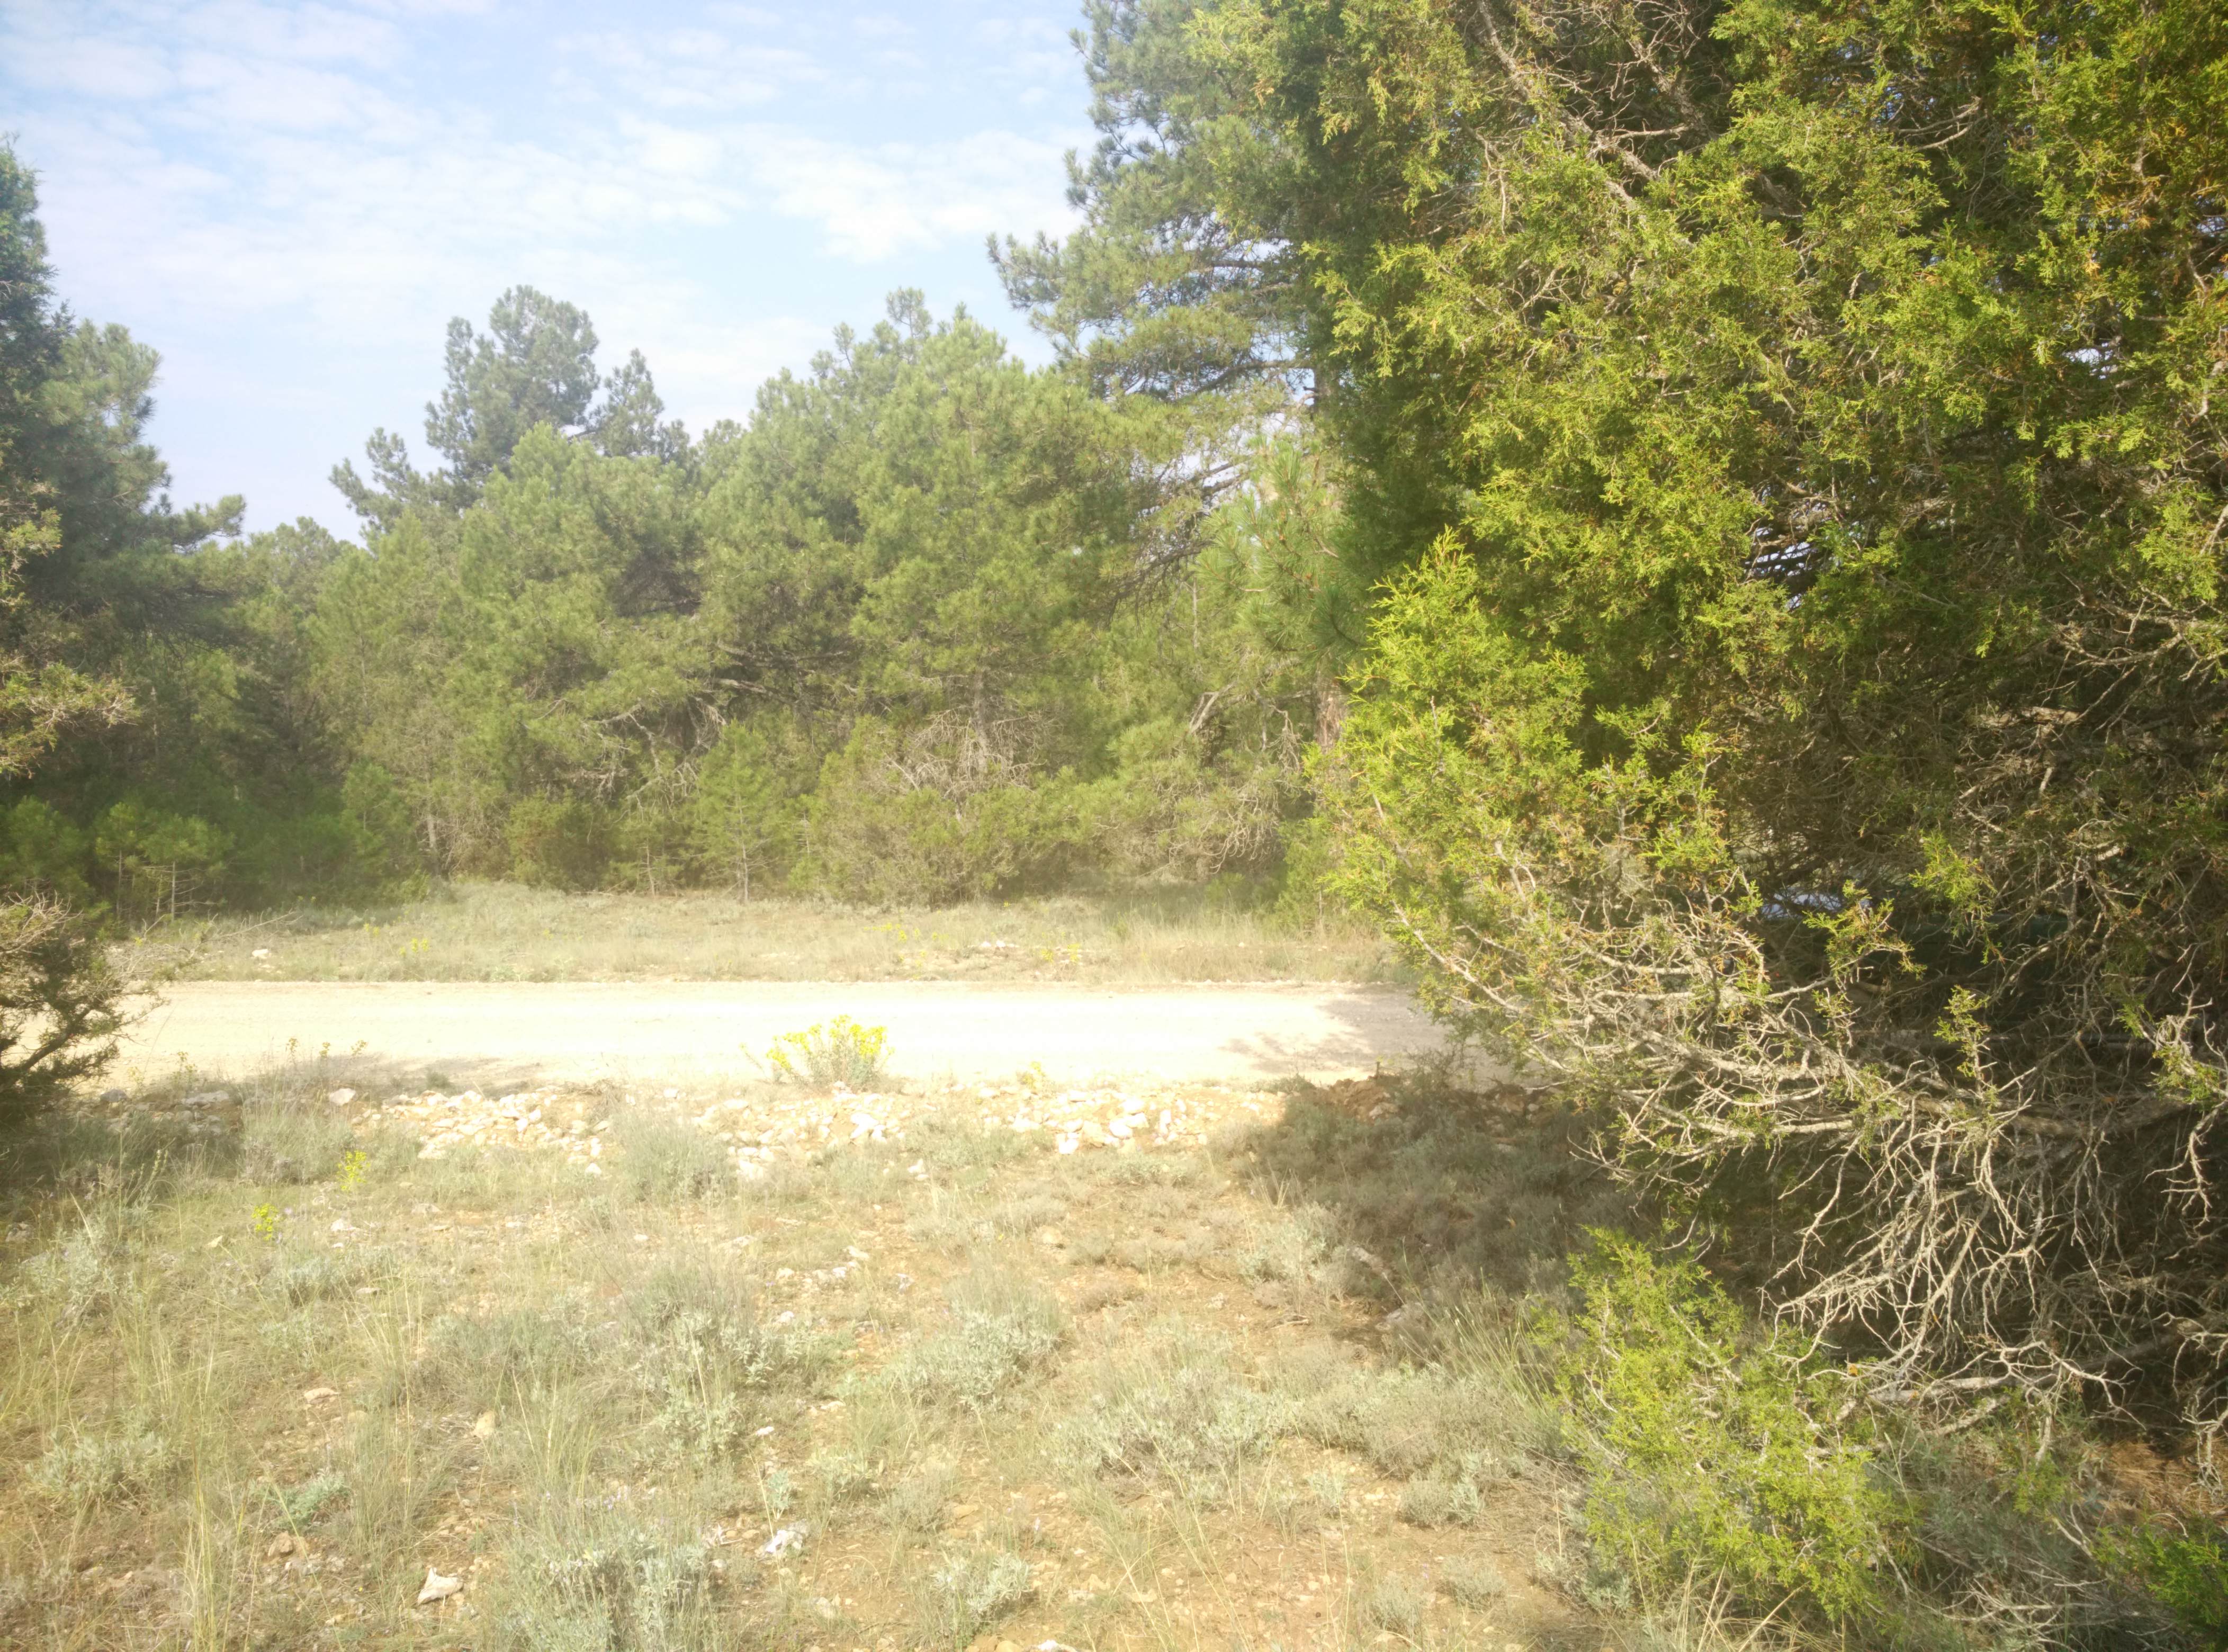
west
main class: Woodland
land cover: Pine dominated coniferous woodland
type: coniferous forest of the mediterranean region
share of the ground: 25 - 50 %
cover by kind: unconsolidated bare surface 40 %, coniferous forest trees 35 %, shrubs 20 %, herbaceous plants 5 %
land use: Semi-natural and natural areas not in use
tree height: > 5 m
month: June
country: ES
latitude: 40.7343
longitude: -1.9933
